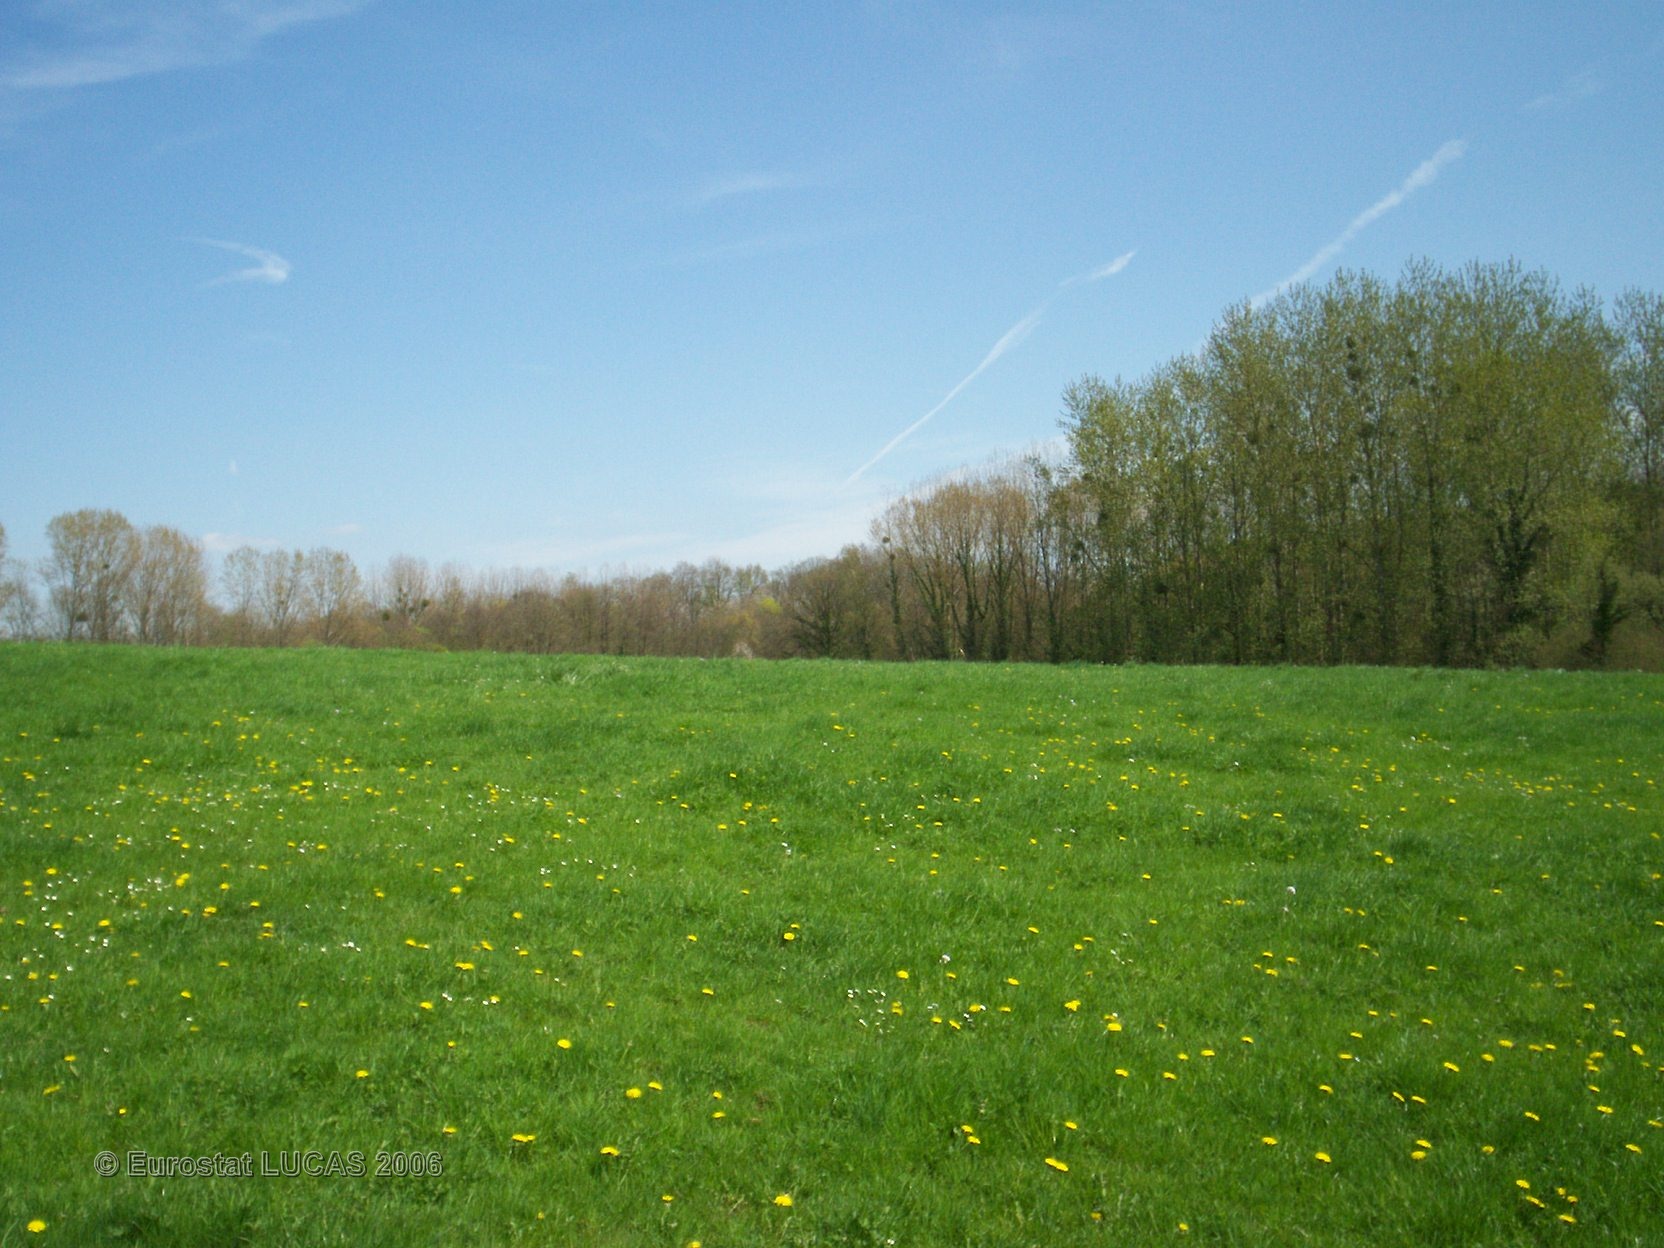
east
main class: Grassland
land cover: Grassland without tree/shrub cover
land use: Agriculture (excluding fallow land and kitchen gardens)
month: April
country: FR
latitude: 49.7183
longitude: 4.3228
